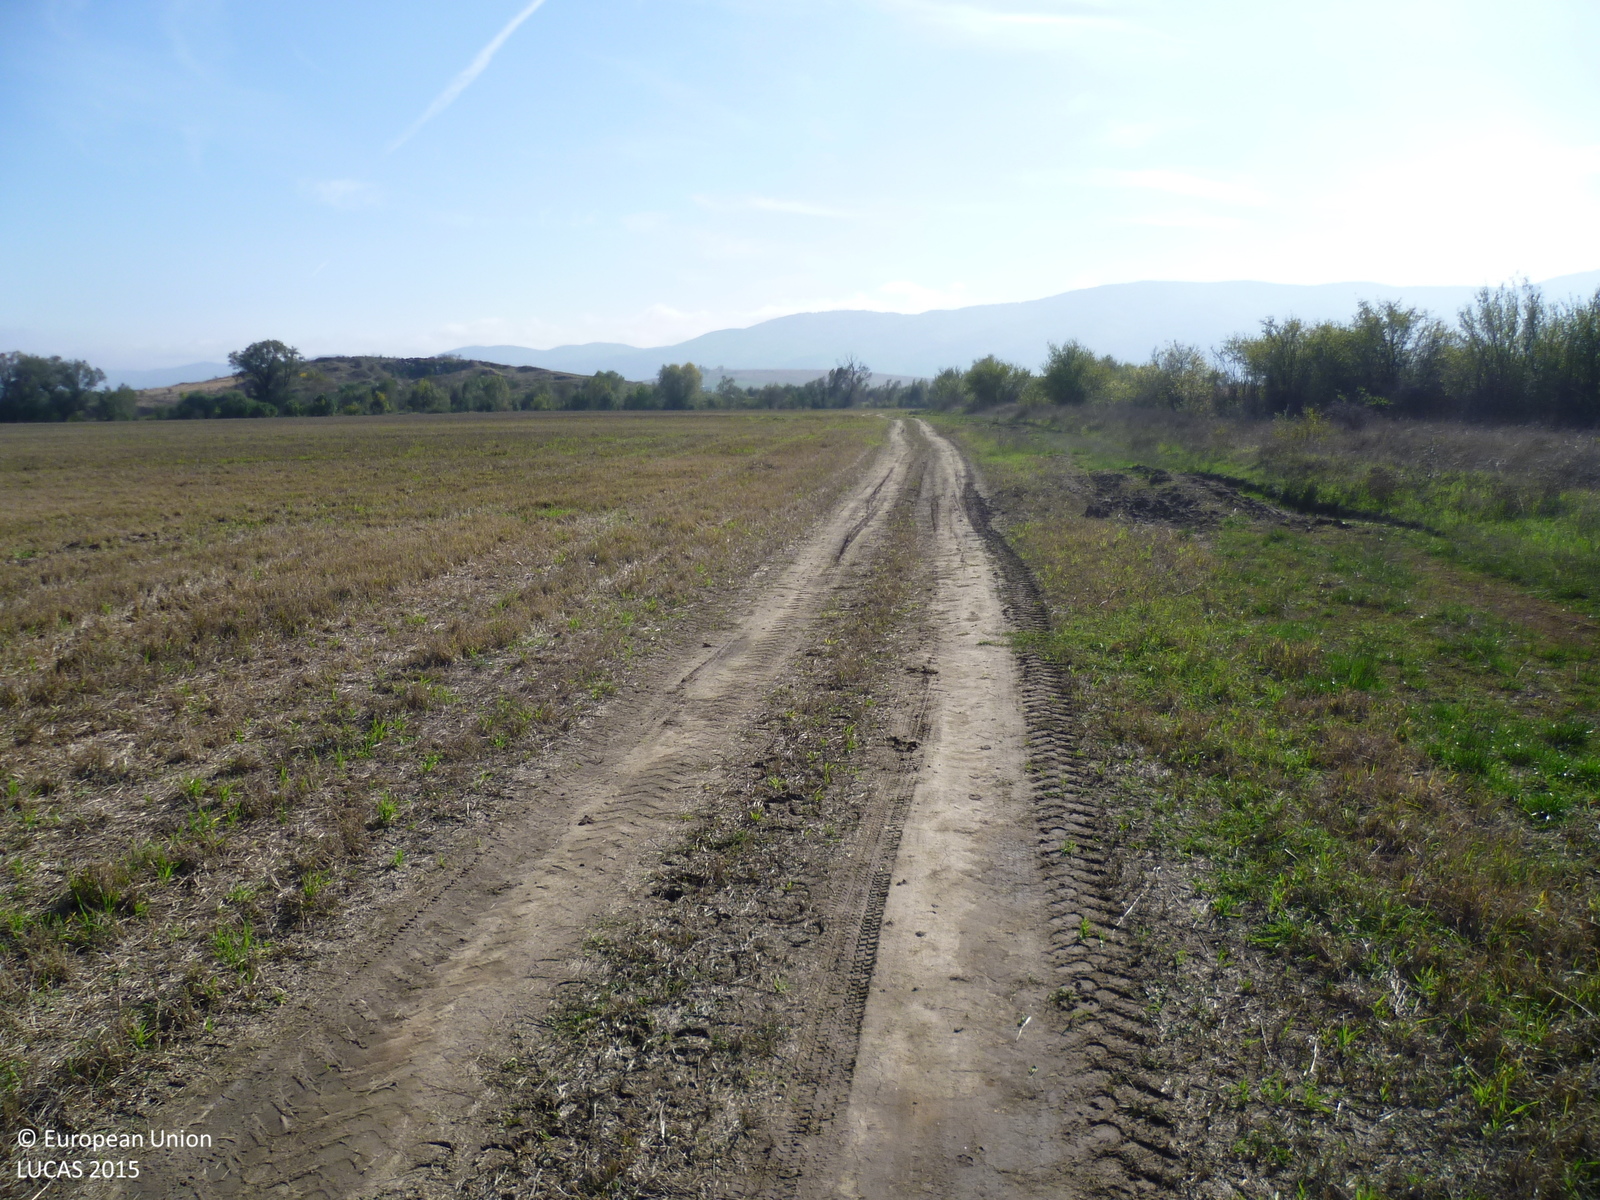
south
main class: Grassland
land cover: Grassland without tree/shrub cover
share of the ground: > 75 %
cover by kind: herbaceous plants 100 %
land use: Agriculture (excluding fallow land and kitchen gardens)
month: October
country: BG
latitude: 42.4621
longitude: 23.7438
